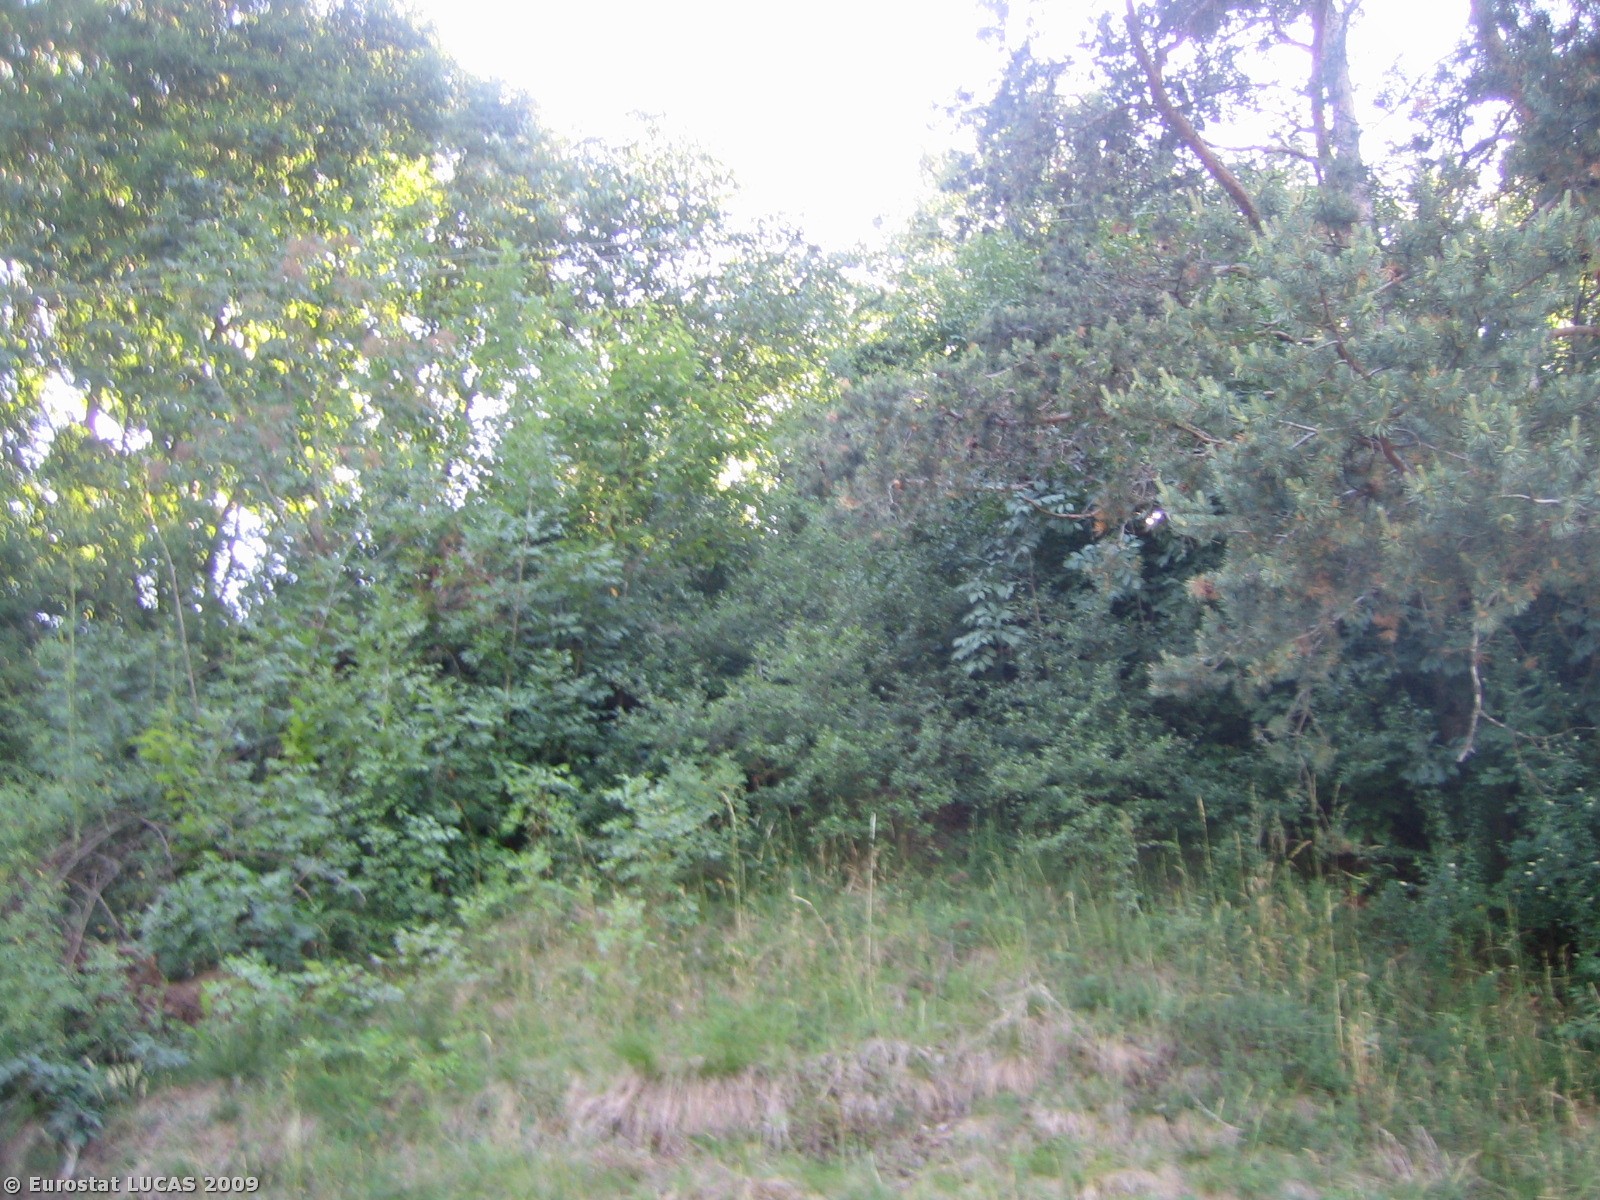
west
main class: Cropland
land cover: Apple fruit
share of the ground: 50 - 75 %
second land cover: Grassland with sparse tree/shrub cover
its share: > 75 %
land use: Agriculture (excluding fallow land and kitchen gardens)
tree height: < 5 m
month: June
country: IT
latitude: 46.7522
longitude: 11.6869
